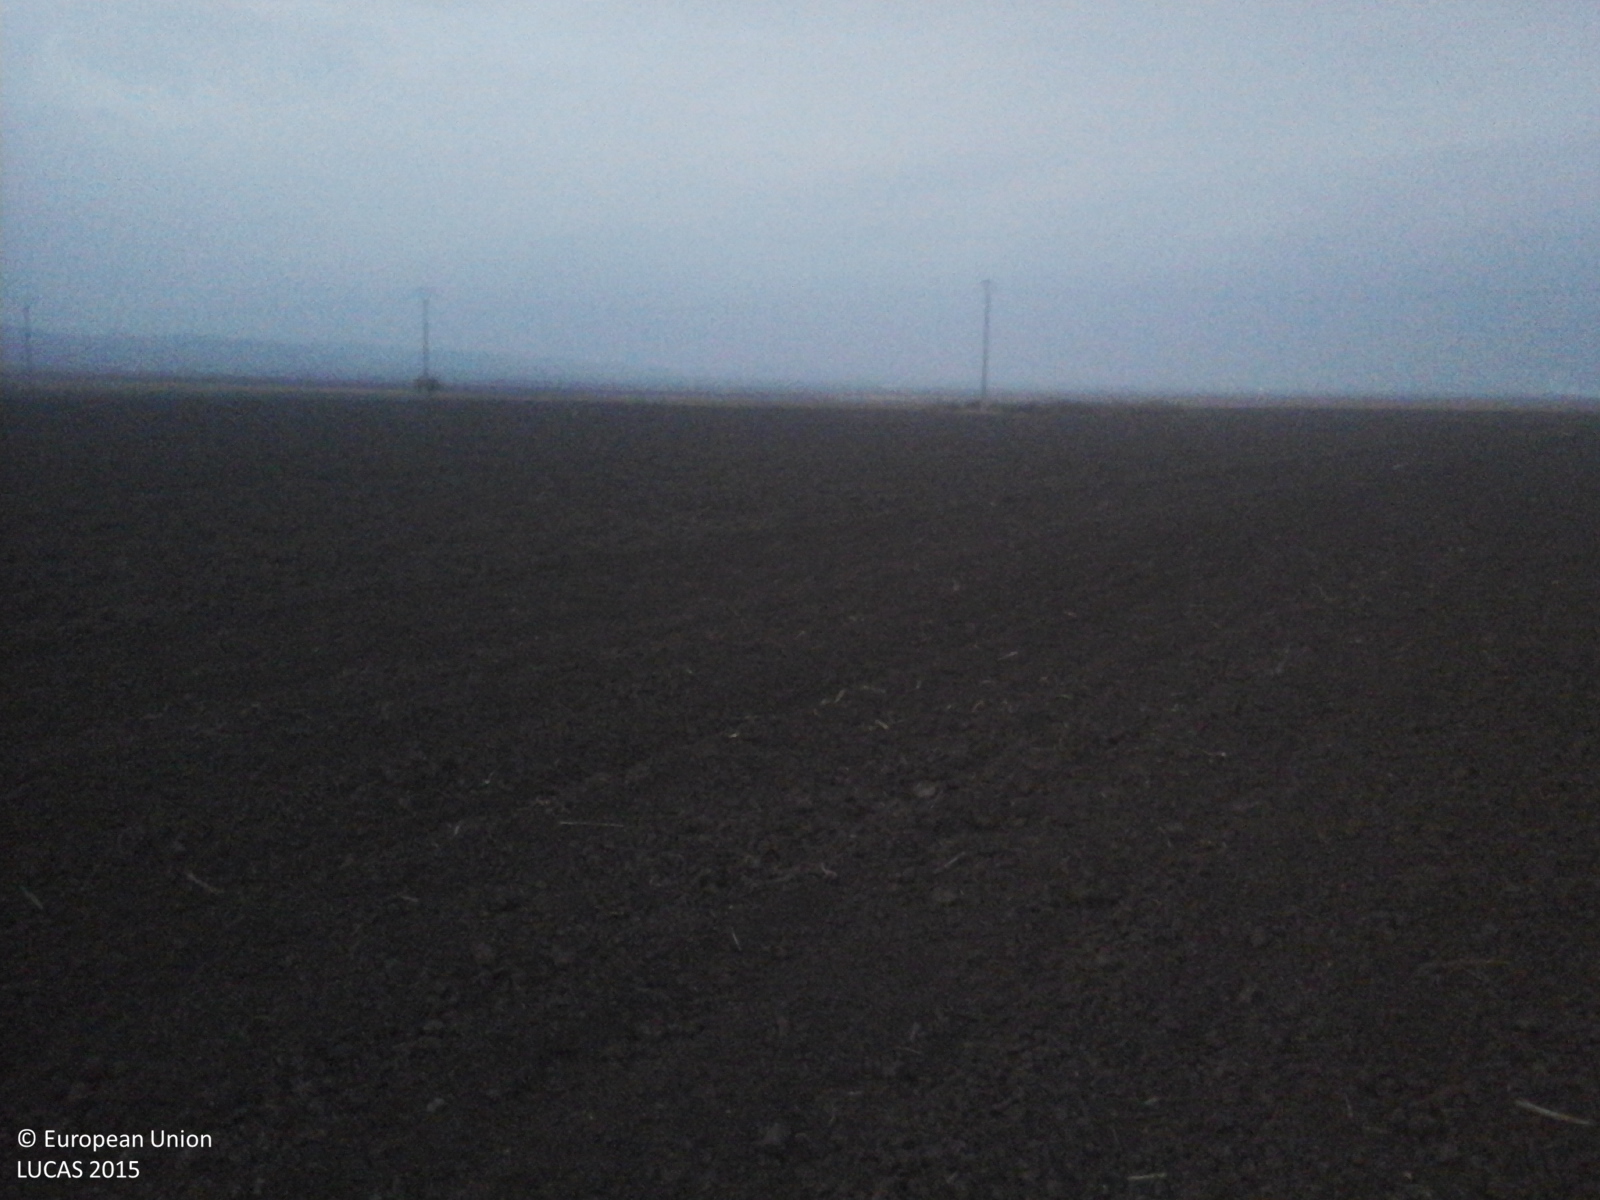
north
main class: Cropland
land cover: Maize
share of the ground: < 10 %
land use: Agriculture (excluding fallow land and kitchen gardens)
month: October
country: RO
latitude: 45.2892
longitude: 27.0057
